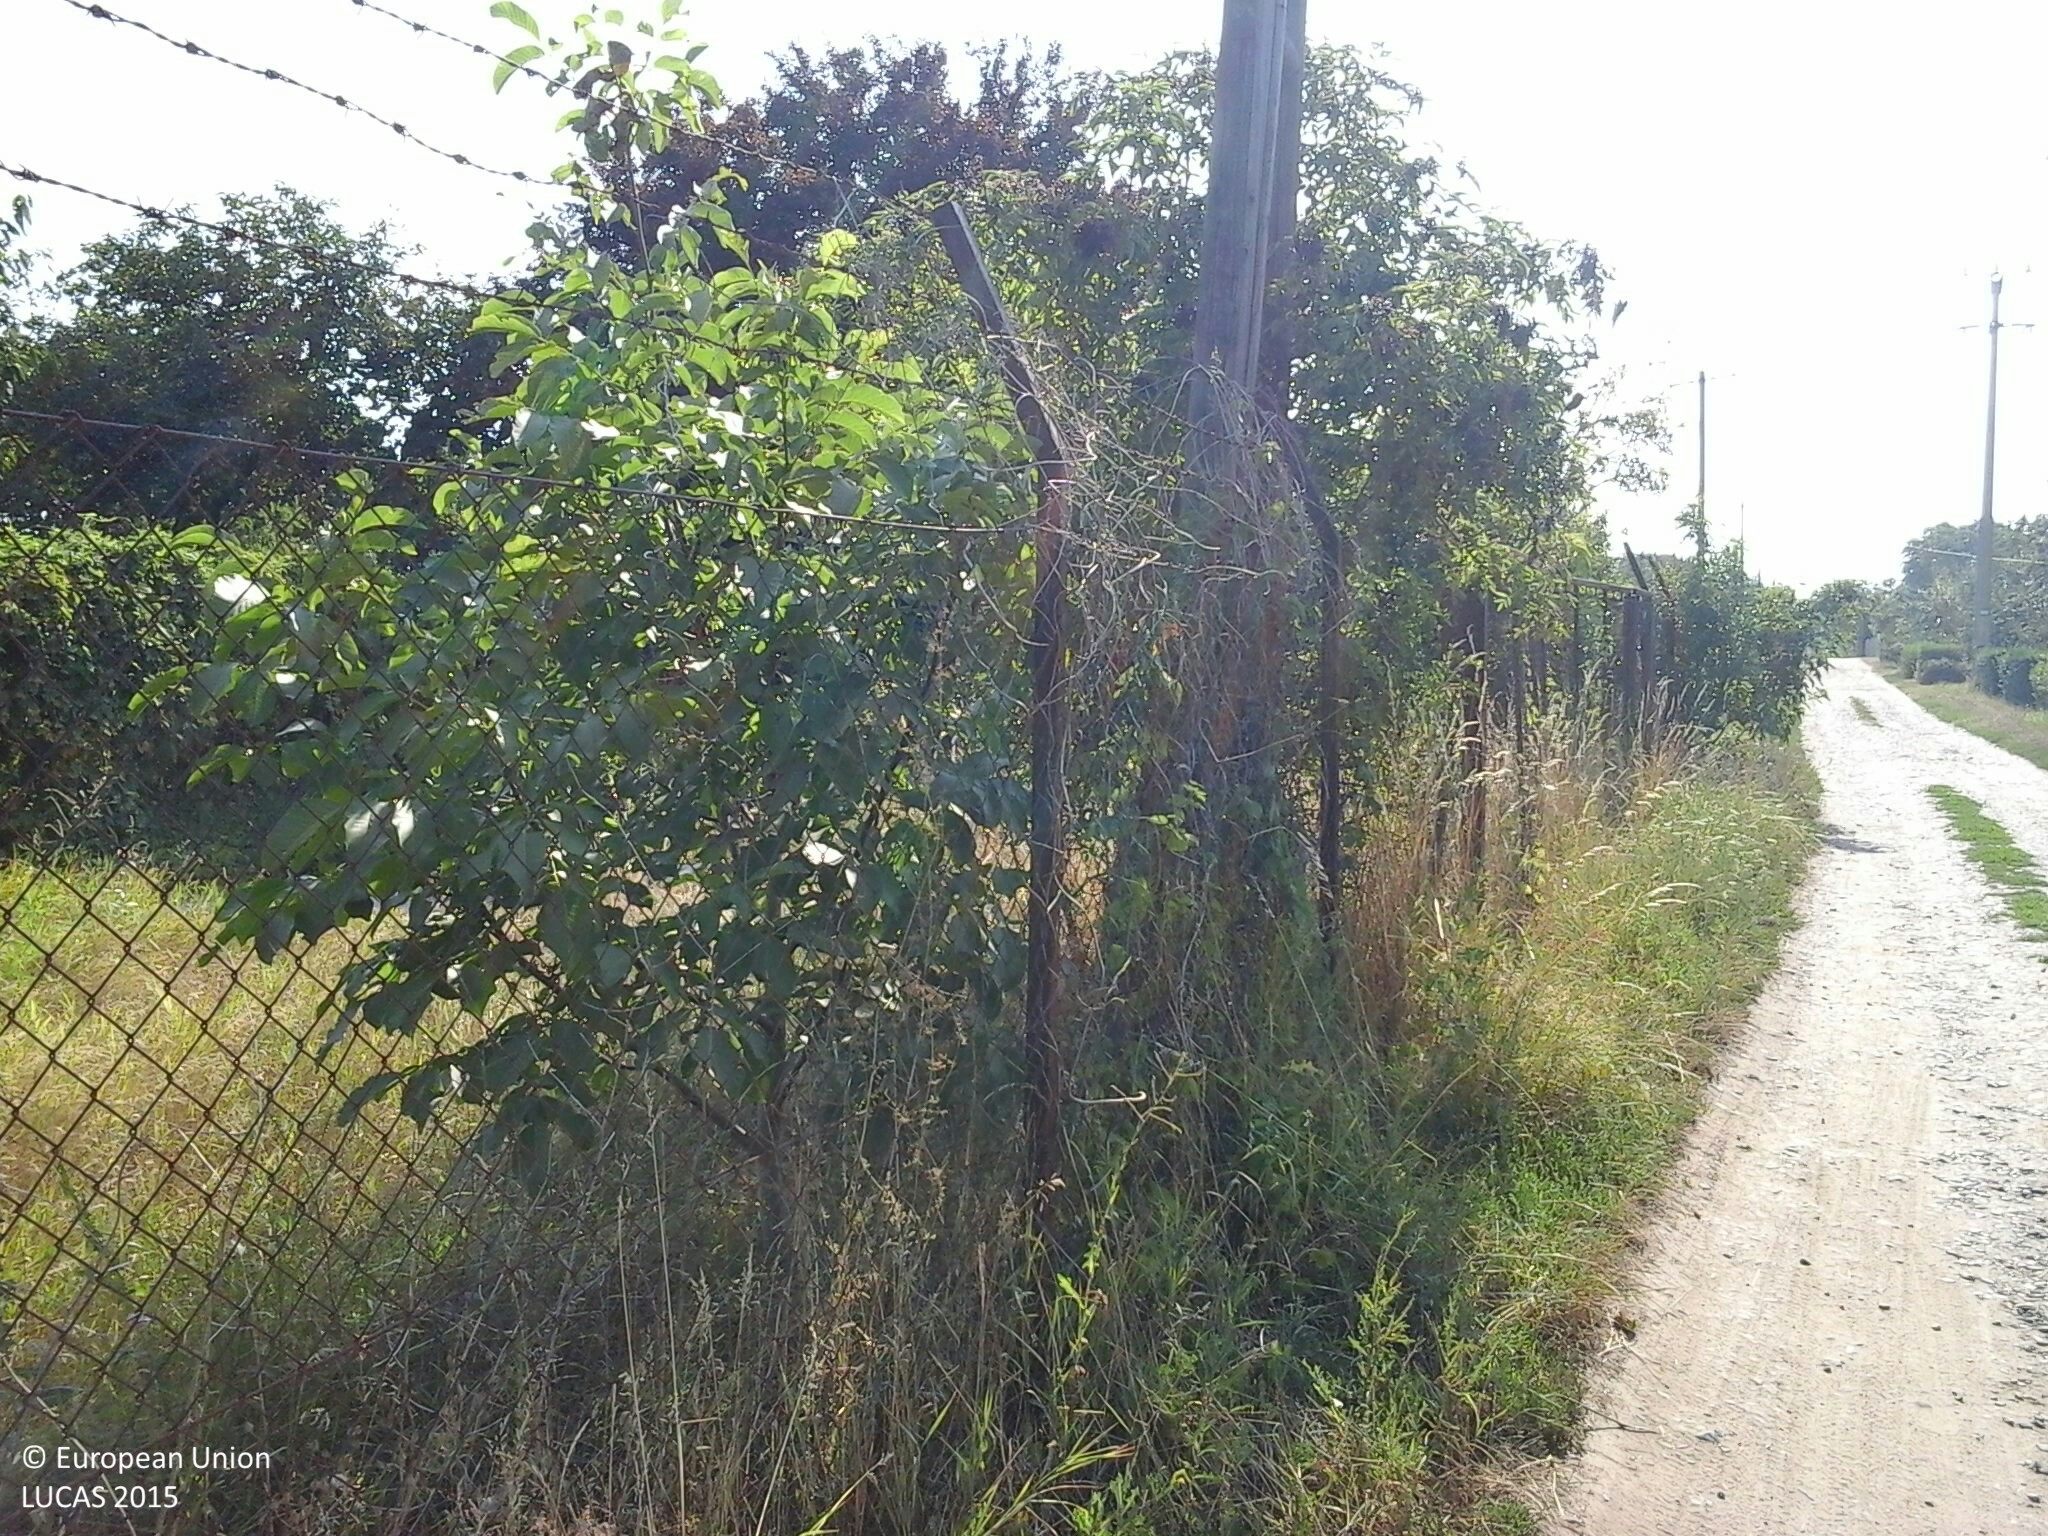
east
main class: Grassland
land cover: Grassland without tree/shrub cover
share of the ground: > 75 %
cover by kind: herbaceous plants 100 %
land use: Residential
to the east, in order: Grassland without tree/shrub cover; Artificial constructions in urban areas
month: July
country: HU
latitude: 47.5802
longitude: 21.3557
